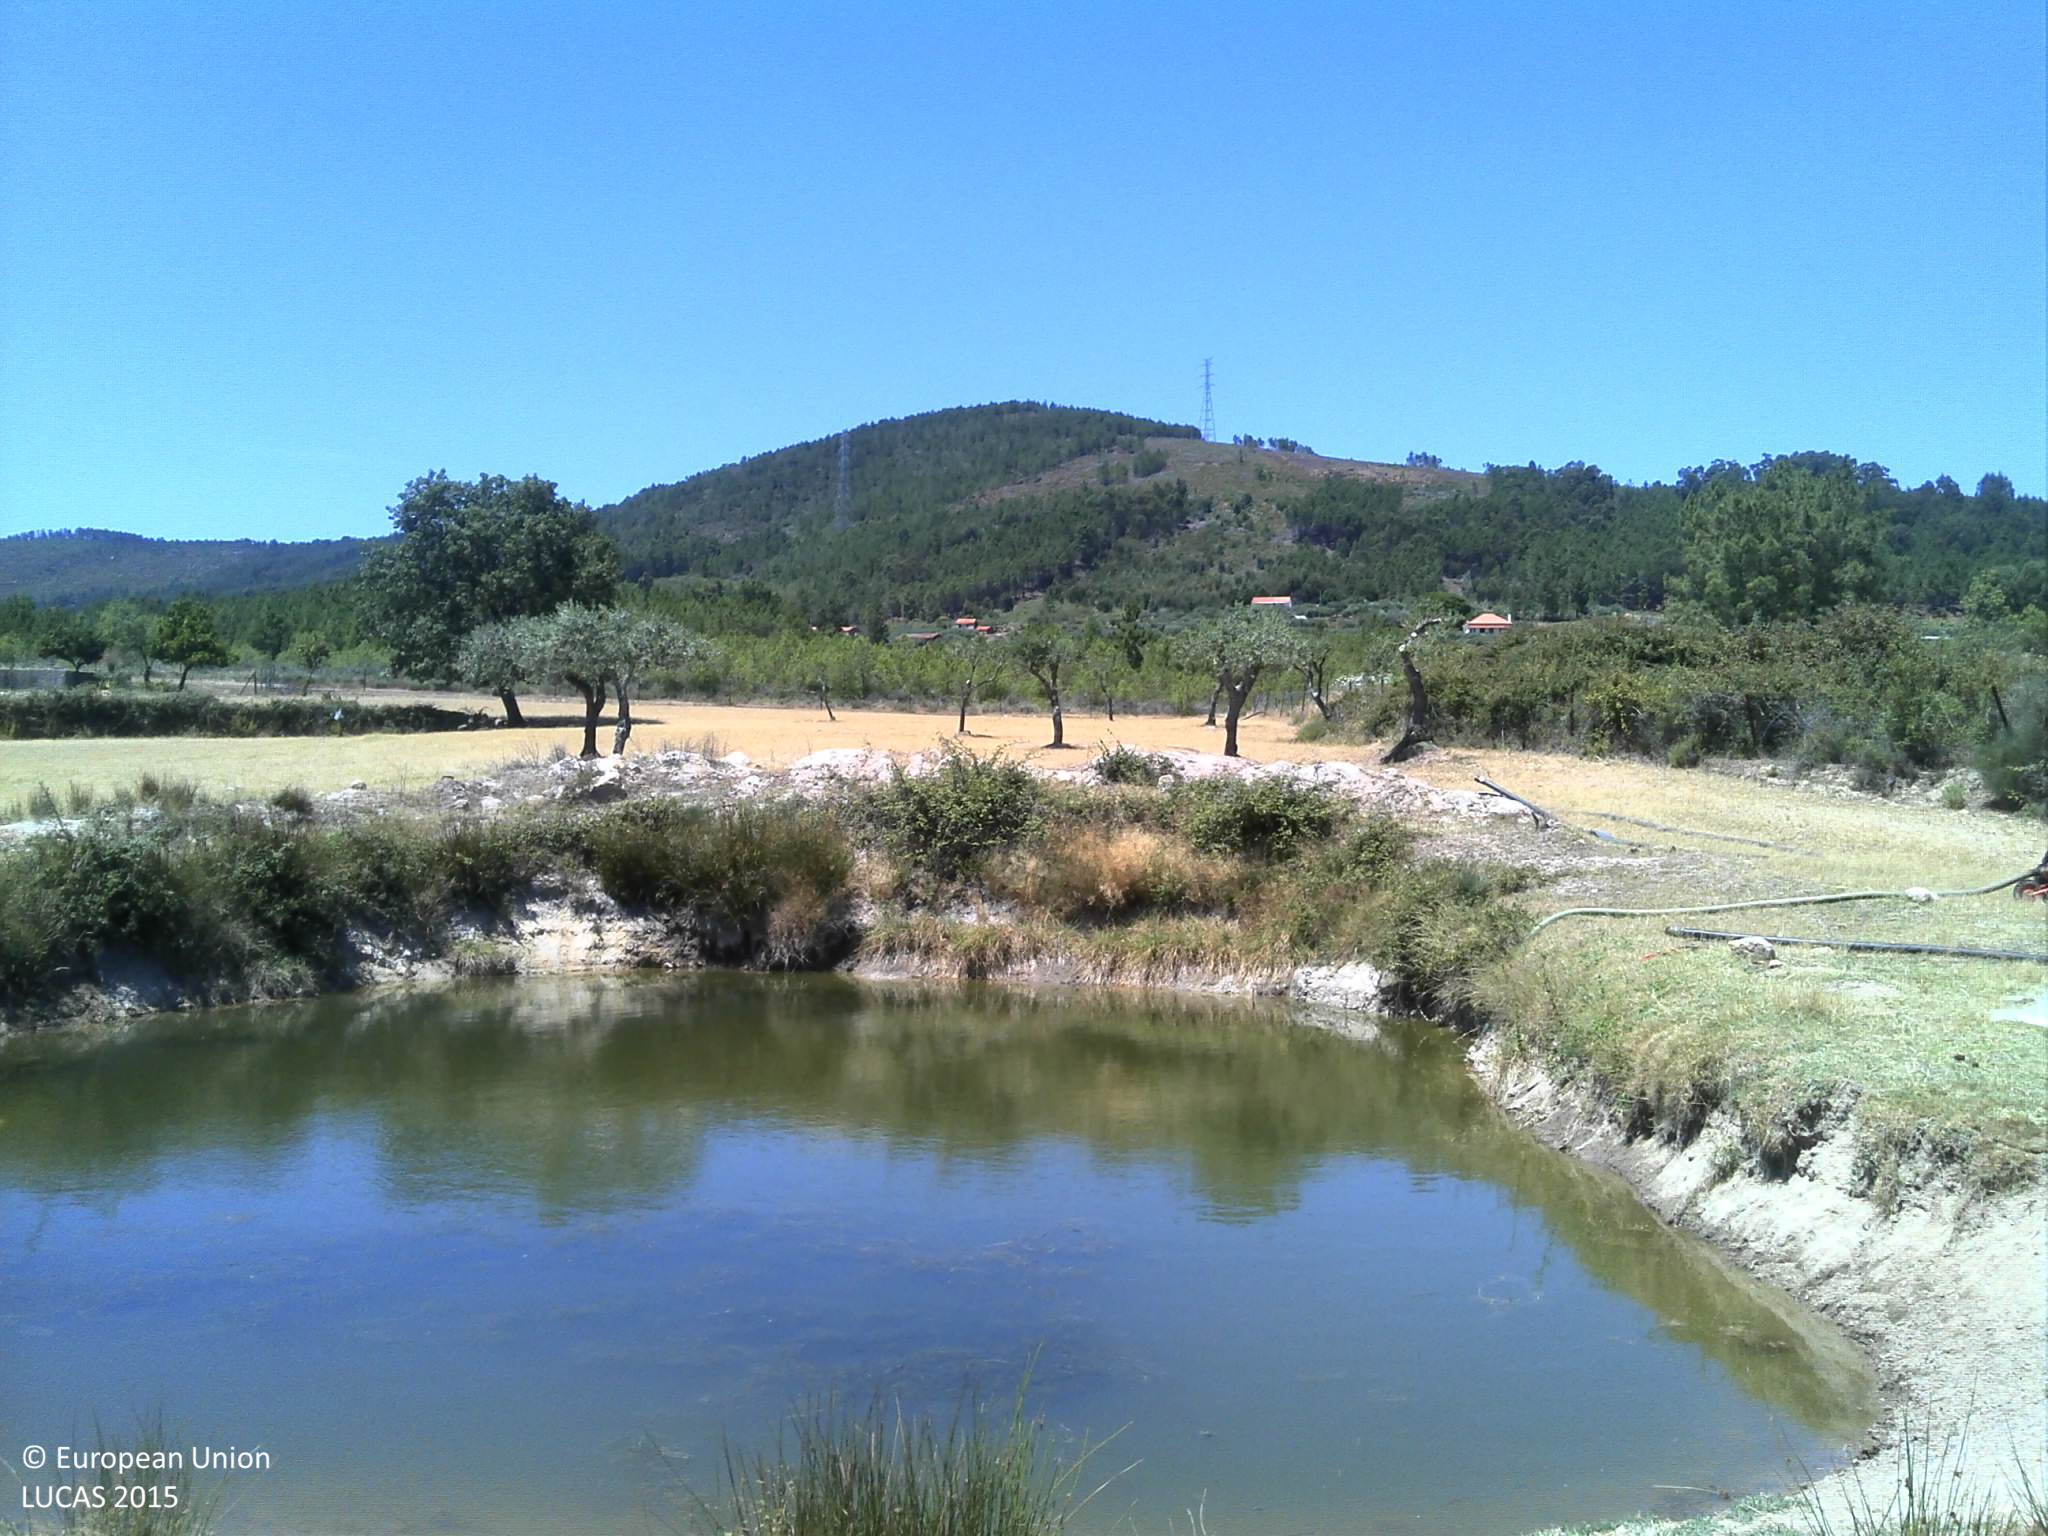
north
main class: Grassland
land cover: Grassland without tree/shrub cover
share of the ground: 25 - 50 %
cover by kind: unconsolidated bare surface 50 %, herbaceous plants 40 %
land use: Agriculture (excluding fallow land and kitchen gardens)
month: June
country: PT
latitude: 40.1049
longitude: -7.3814
